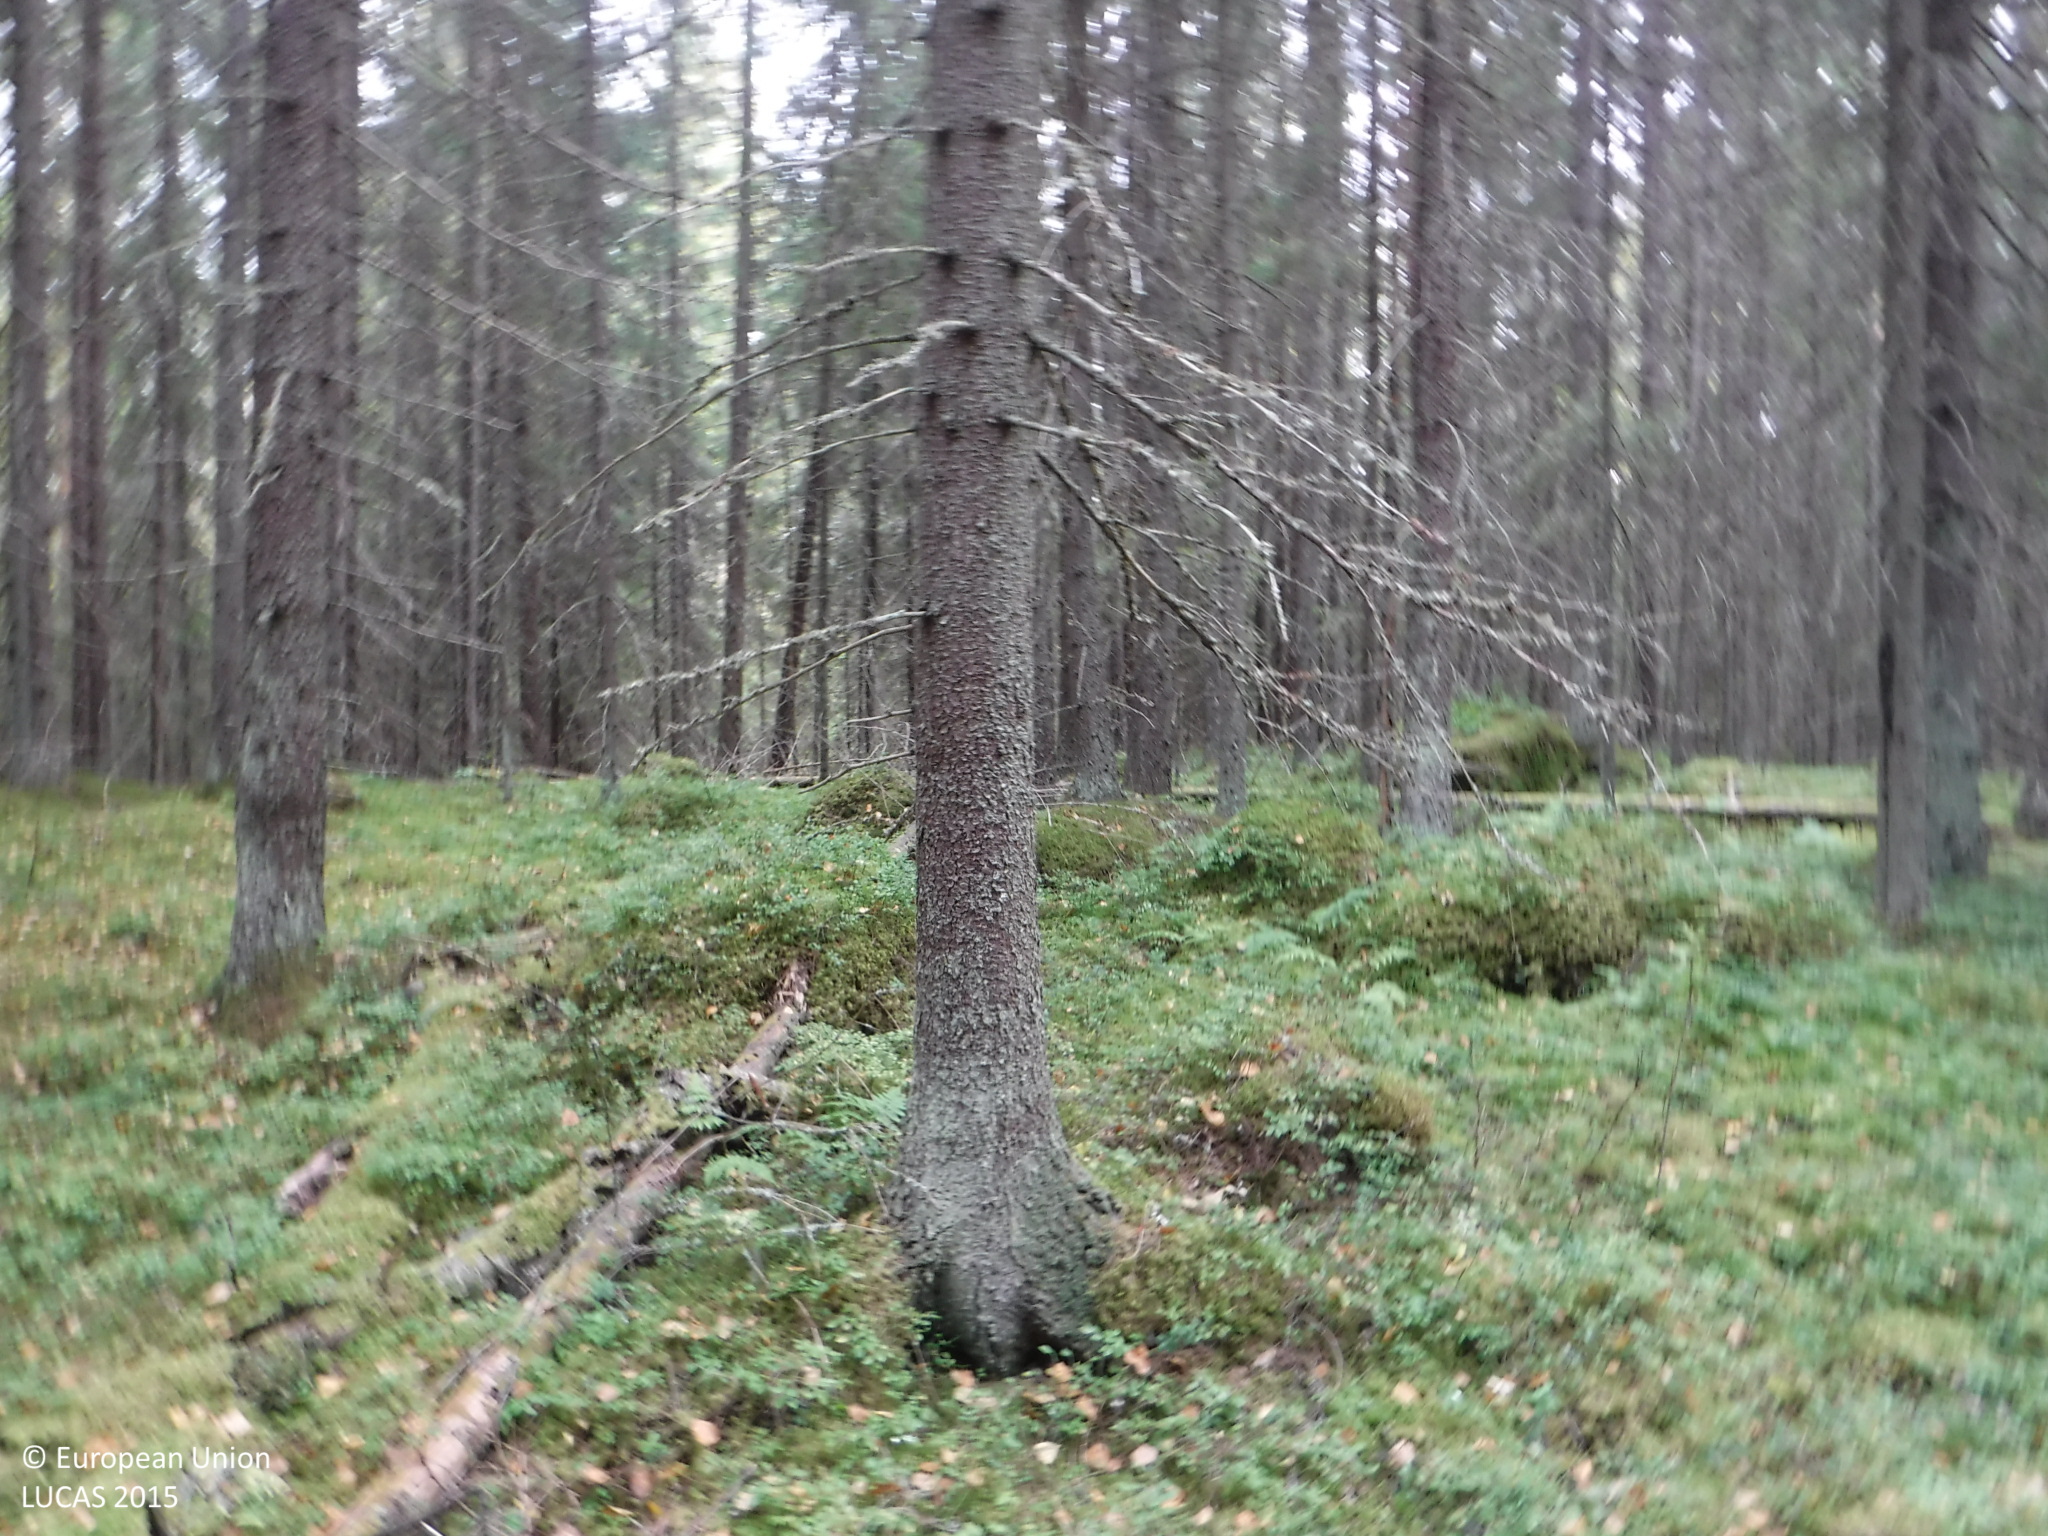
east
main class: Woodland
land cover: Spruce dominated coniferous woodland
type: boreal forest
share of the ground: 50 - 75 %
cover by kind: coniferous forest trees 65 %, lichens and mosses 25 %, shrubs 10 %
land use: Forestry
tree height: > 5 m
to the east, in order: Spruce dominated coniferous woodland; Ditches and canals; Other mixed woodland; Ditches and canals; Other mixed woodland; Ditches and canals; Pine dominated coniferous woodland; Pine dominated mixed woodland; Electric lines; Pine dominated mixed woodland; Pine dominated coniferous woodland; Ditches and canals; Pine dominated coniferous woodland; Other mixed woodland; Peatbogs
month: September
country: FI
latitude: 61.7404
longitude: 22.0783
